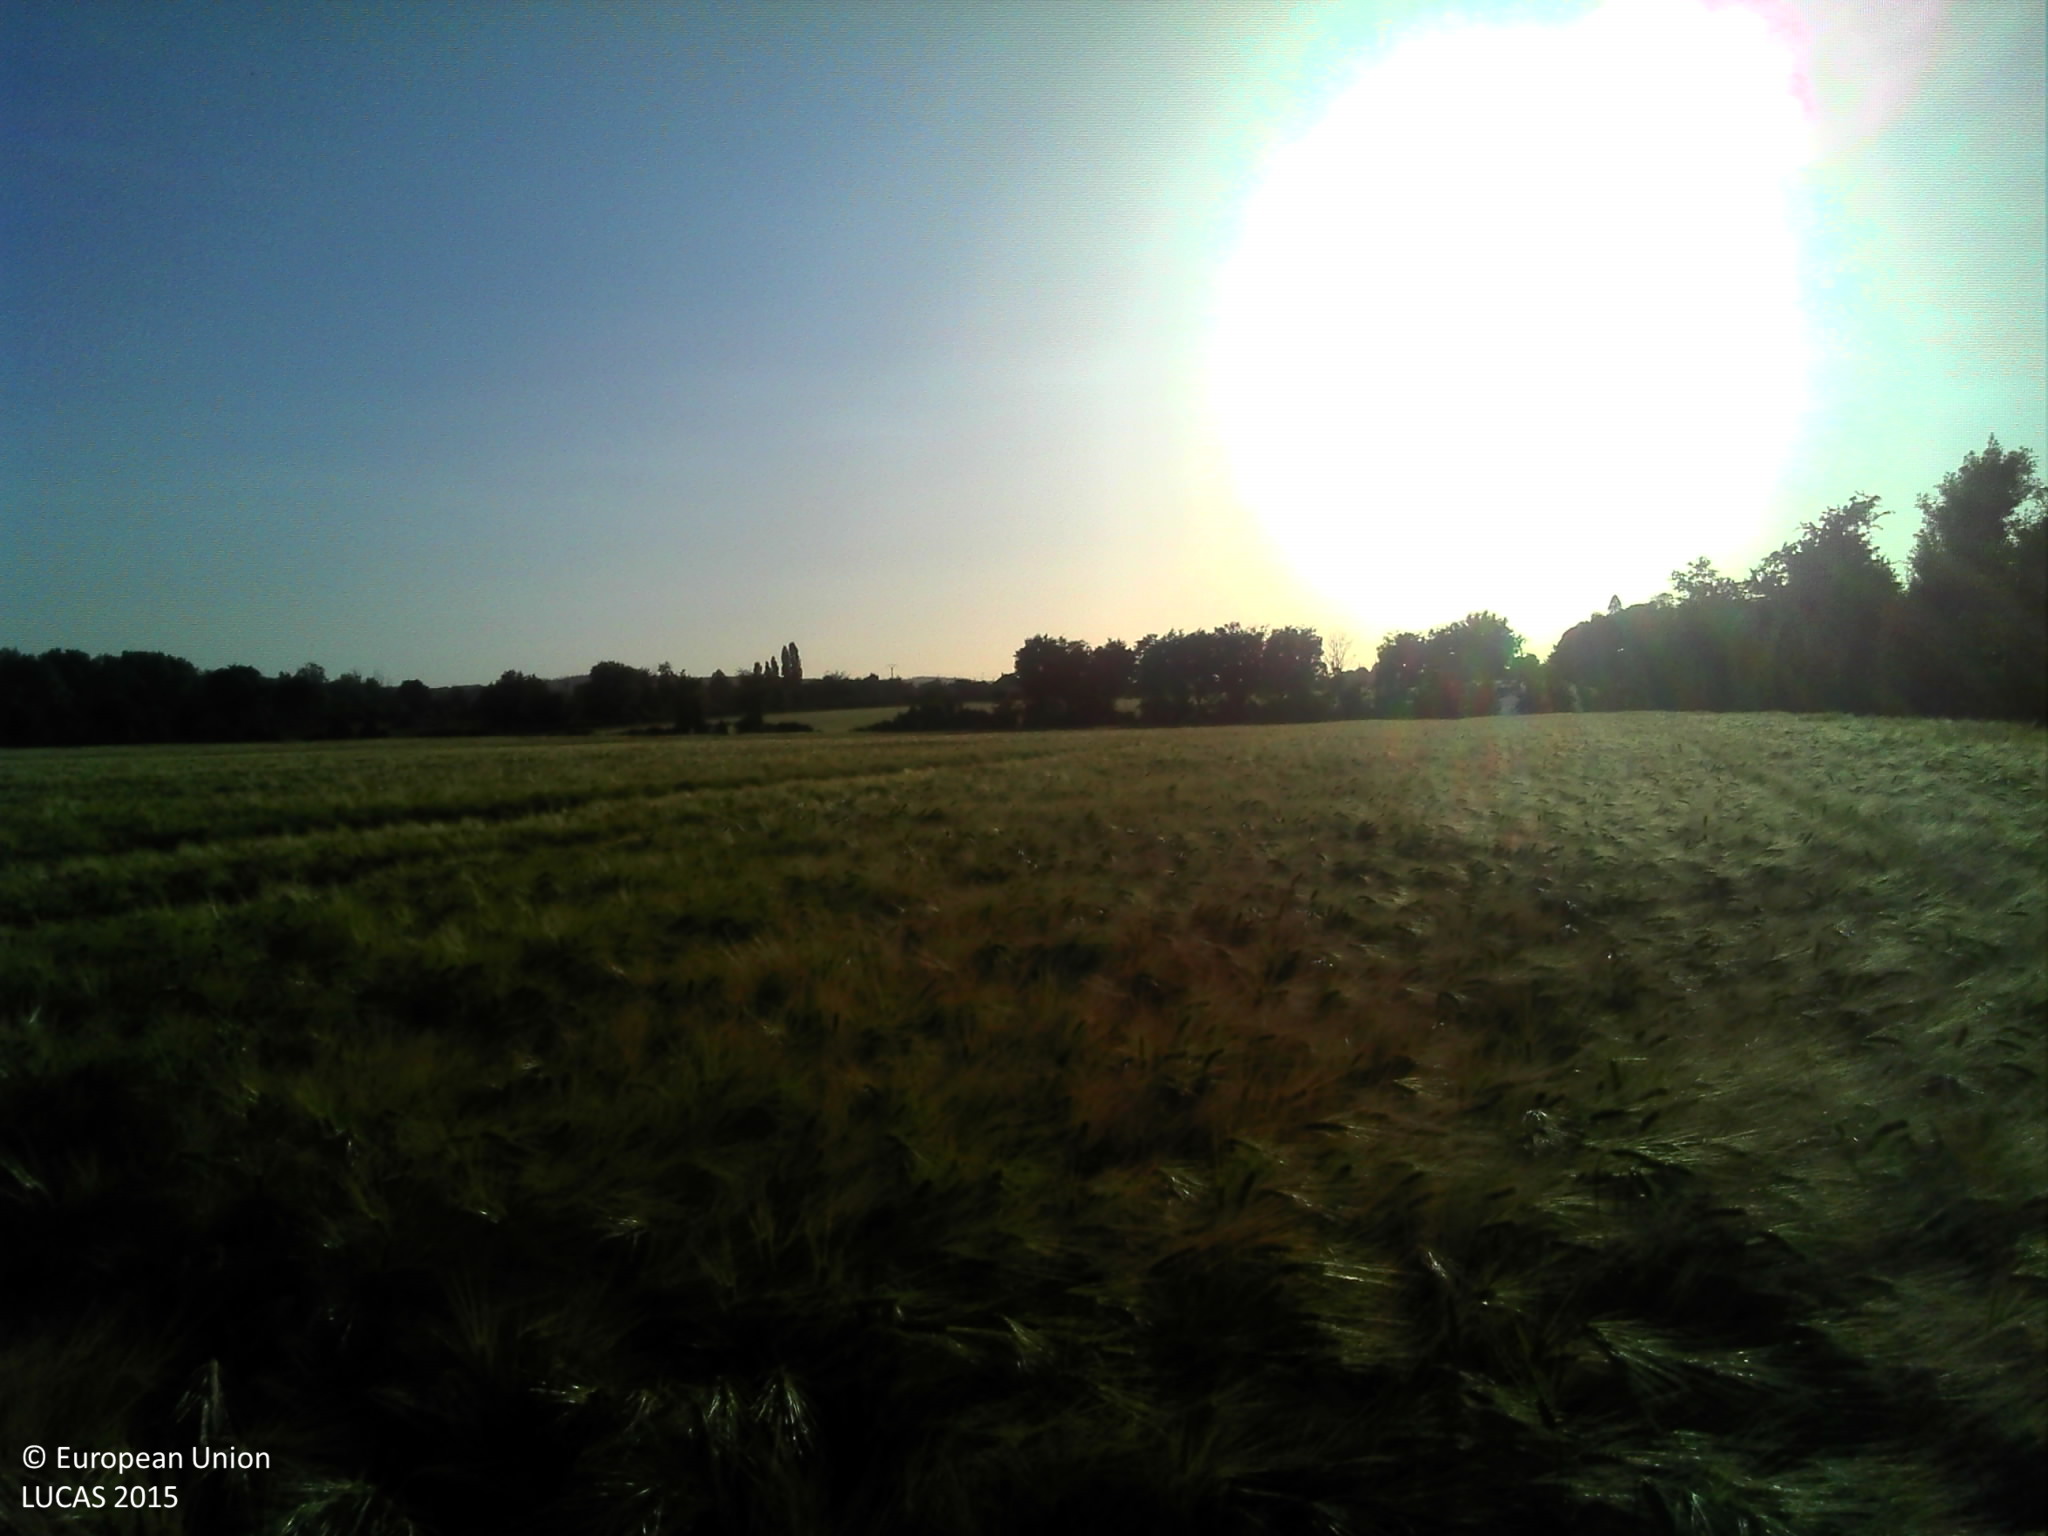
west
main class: Cropland
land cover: Barley
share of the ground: > 75 %
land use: Agriculture (excluding fallow land and kitchen gardens)
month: June
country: FR
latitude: 48.7897
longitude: 0.0749
